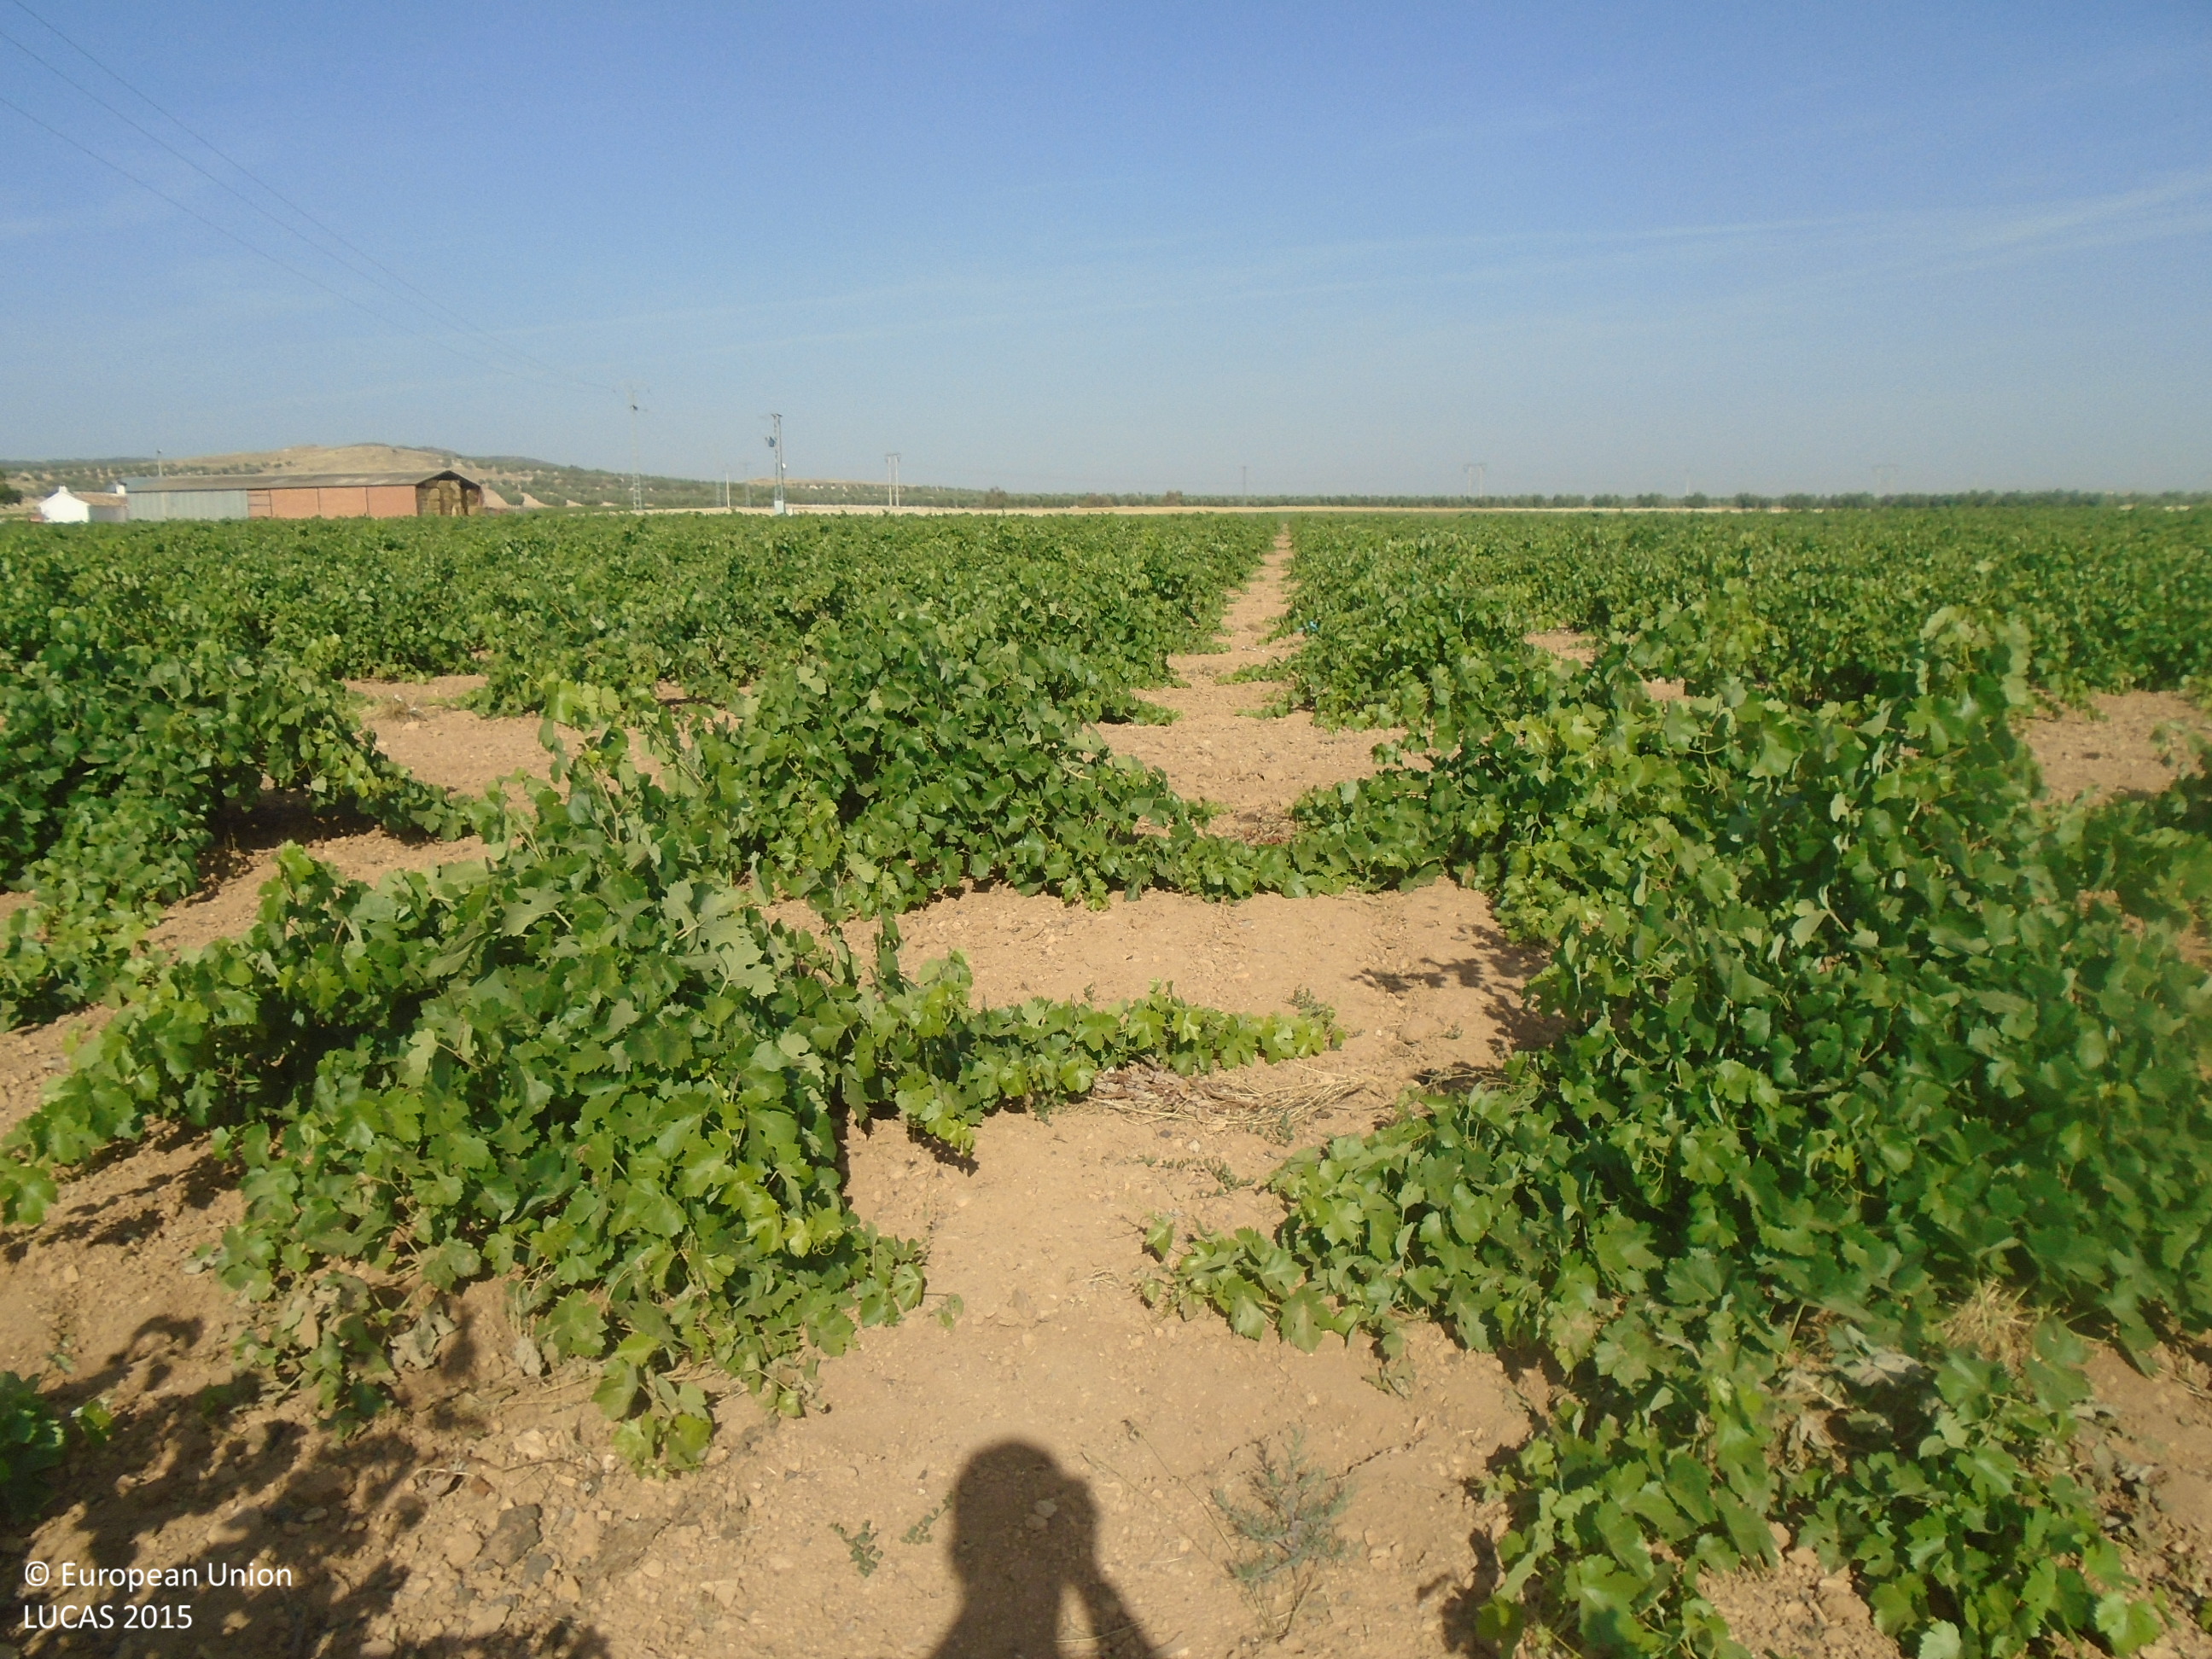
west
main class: Cropland
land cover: Vineyards
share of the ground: 10 - 25 %
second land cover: Other bare soil
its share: > 75 %
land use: Agriculture (excluding fallow land and kitchen gardens)
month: July
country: ES
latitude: 39.3991
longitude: -3.5266
